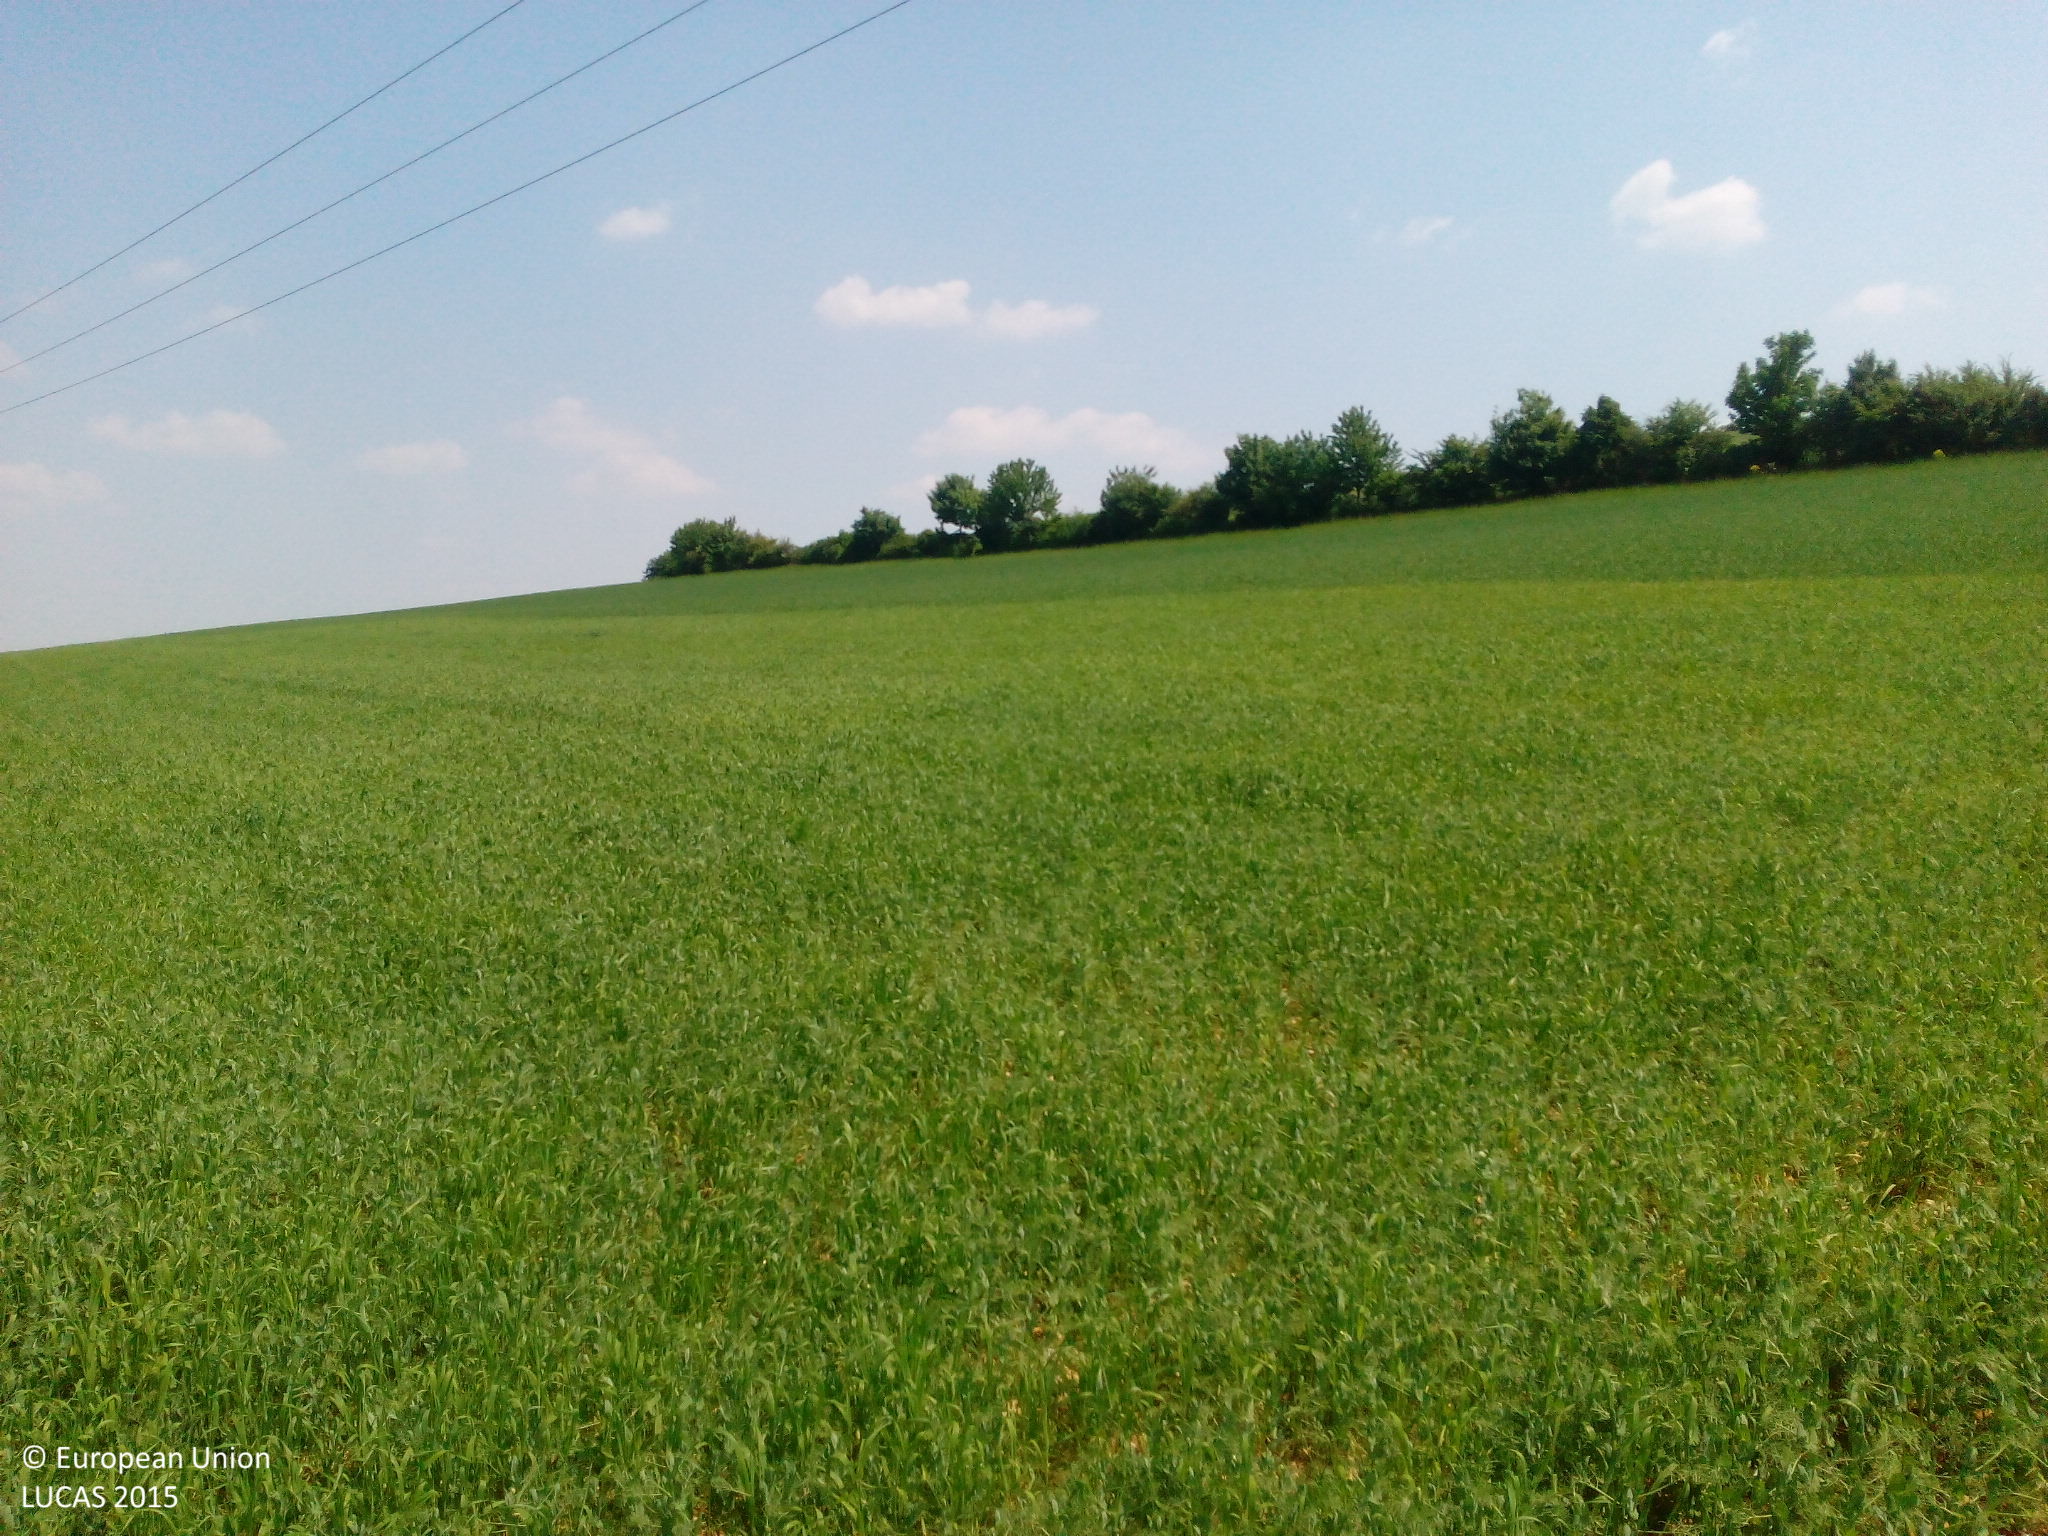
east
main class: Cropland
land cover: Other leguminous and mixtures for fodder
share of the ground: 50 - 75 %
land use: Agriculture (excluding fallow land and kitchen gardens)
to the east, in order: Other leguminous and mixtures for fodder; Electric lines; Other leguminous and mixtures for fodder; Common wheat; Tracks; Abandoned hedges; Paved roads, cycling and walking lanes; Rape and turnip rape
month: May
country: DE
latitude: 49.6279
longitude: 8.0484
